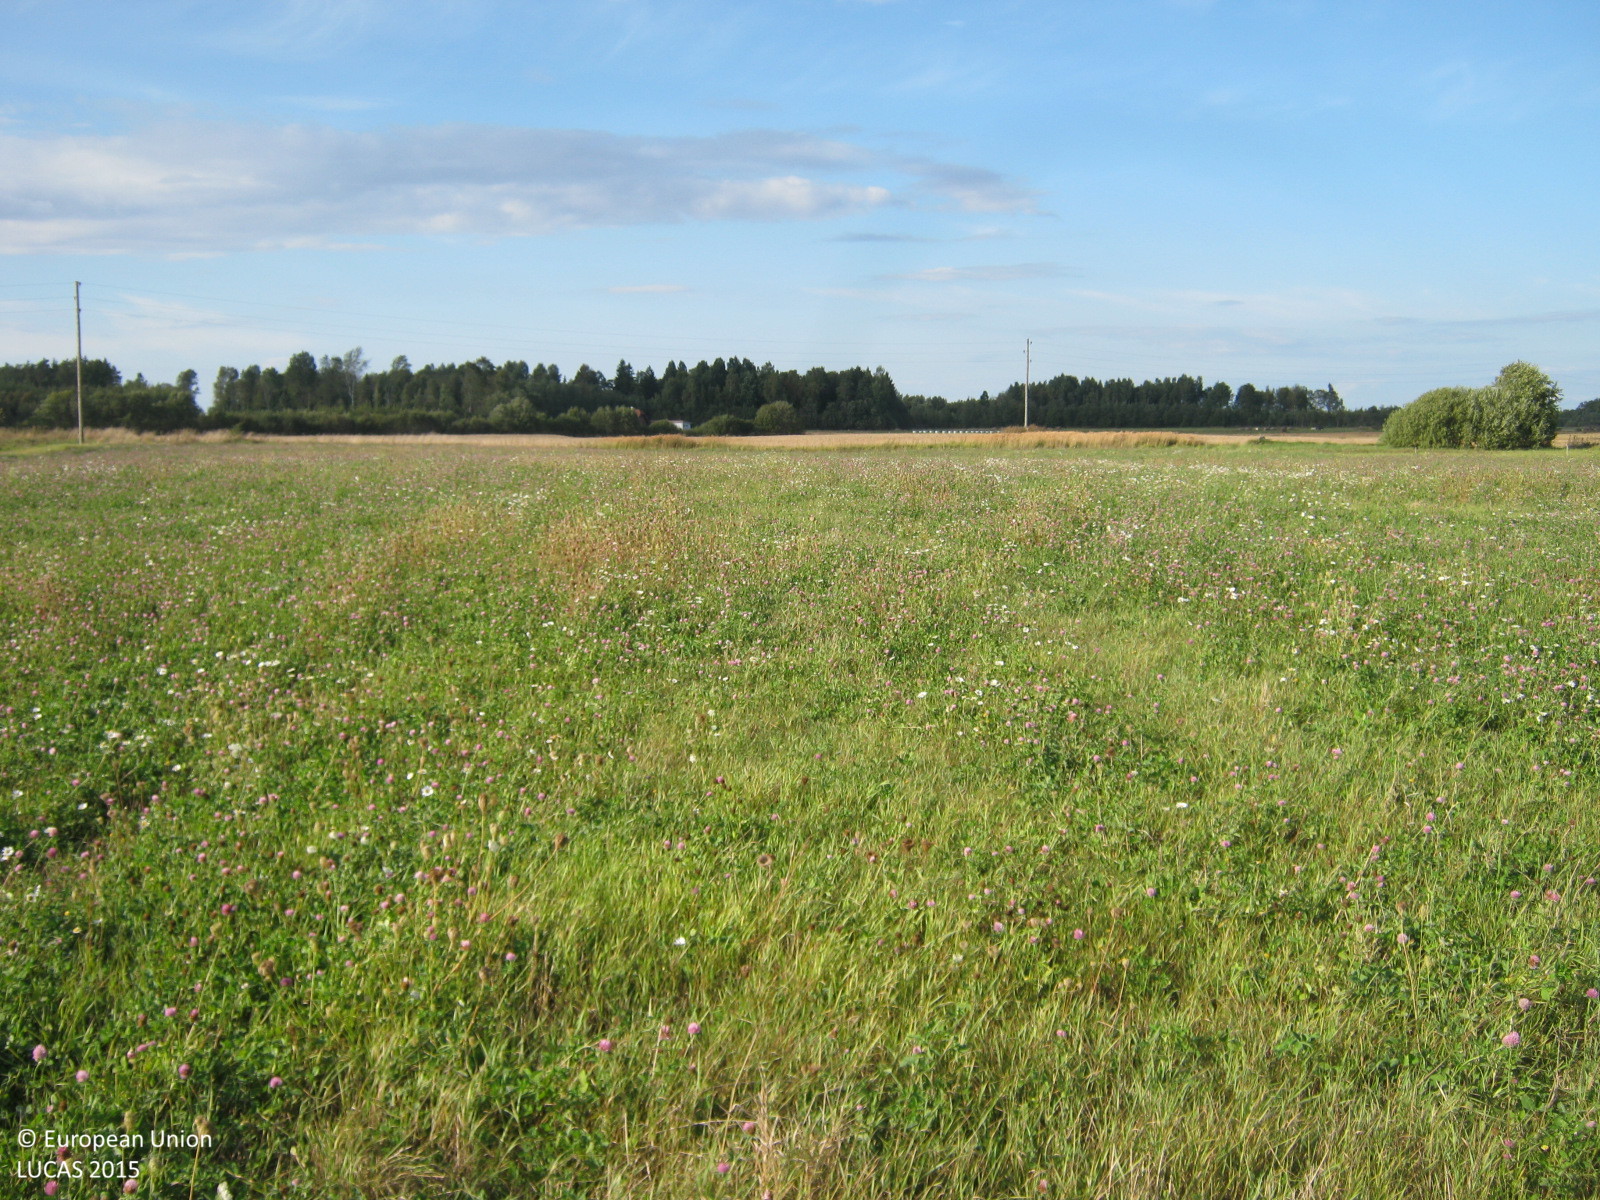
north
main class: Cropland
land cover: Clovers
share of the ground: > 75 %
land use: Agriculture (excluding fallow land and kitchen gardens)
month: September
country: LV
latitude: 57.3360
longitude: 24.4951
